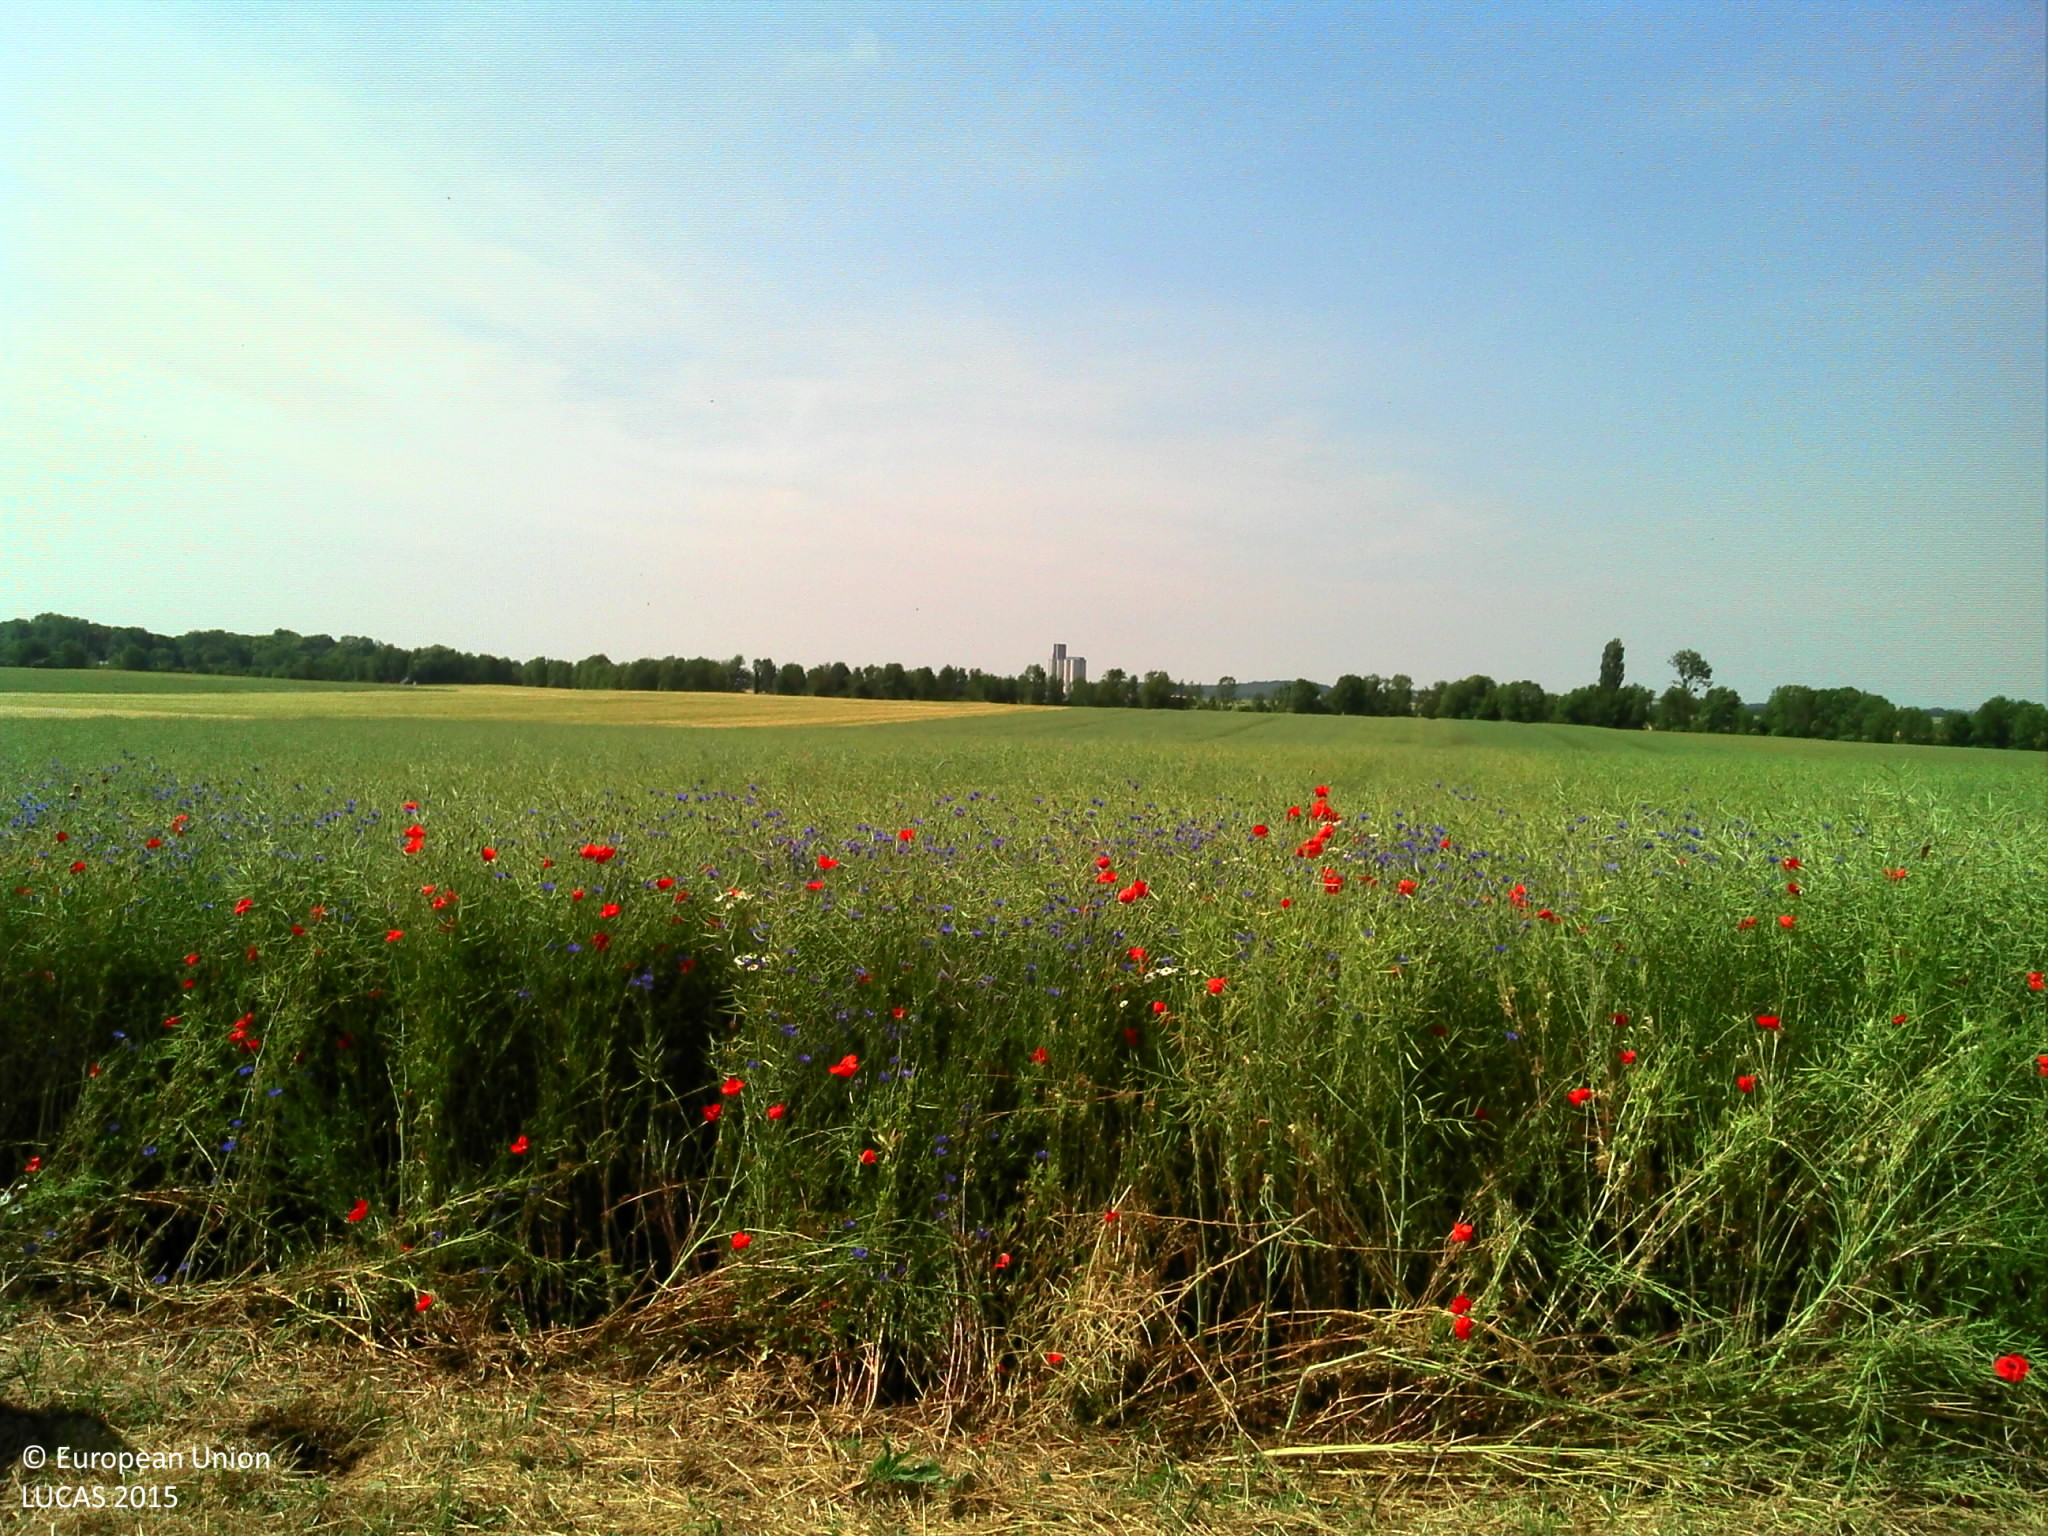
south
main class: Cropland
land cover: Rape and turnip rape
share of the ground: > 75 %
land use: Agriculture (excluding fallow land and kitchen gardens)
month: June
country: FR
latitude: 47.5064
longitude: 5.2075
